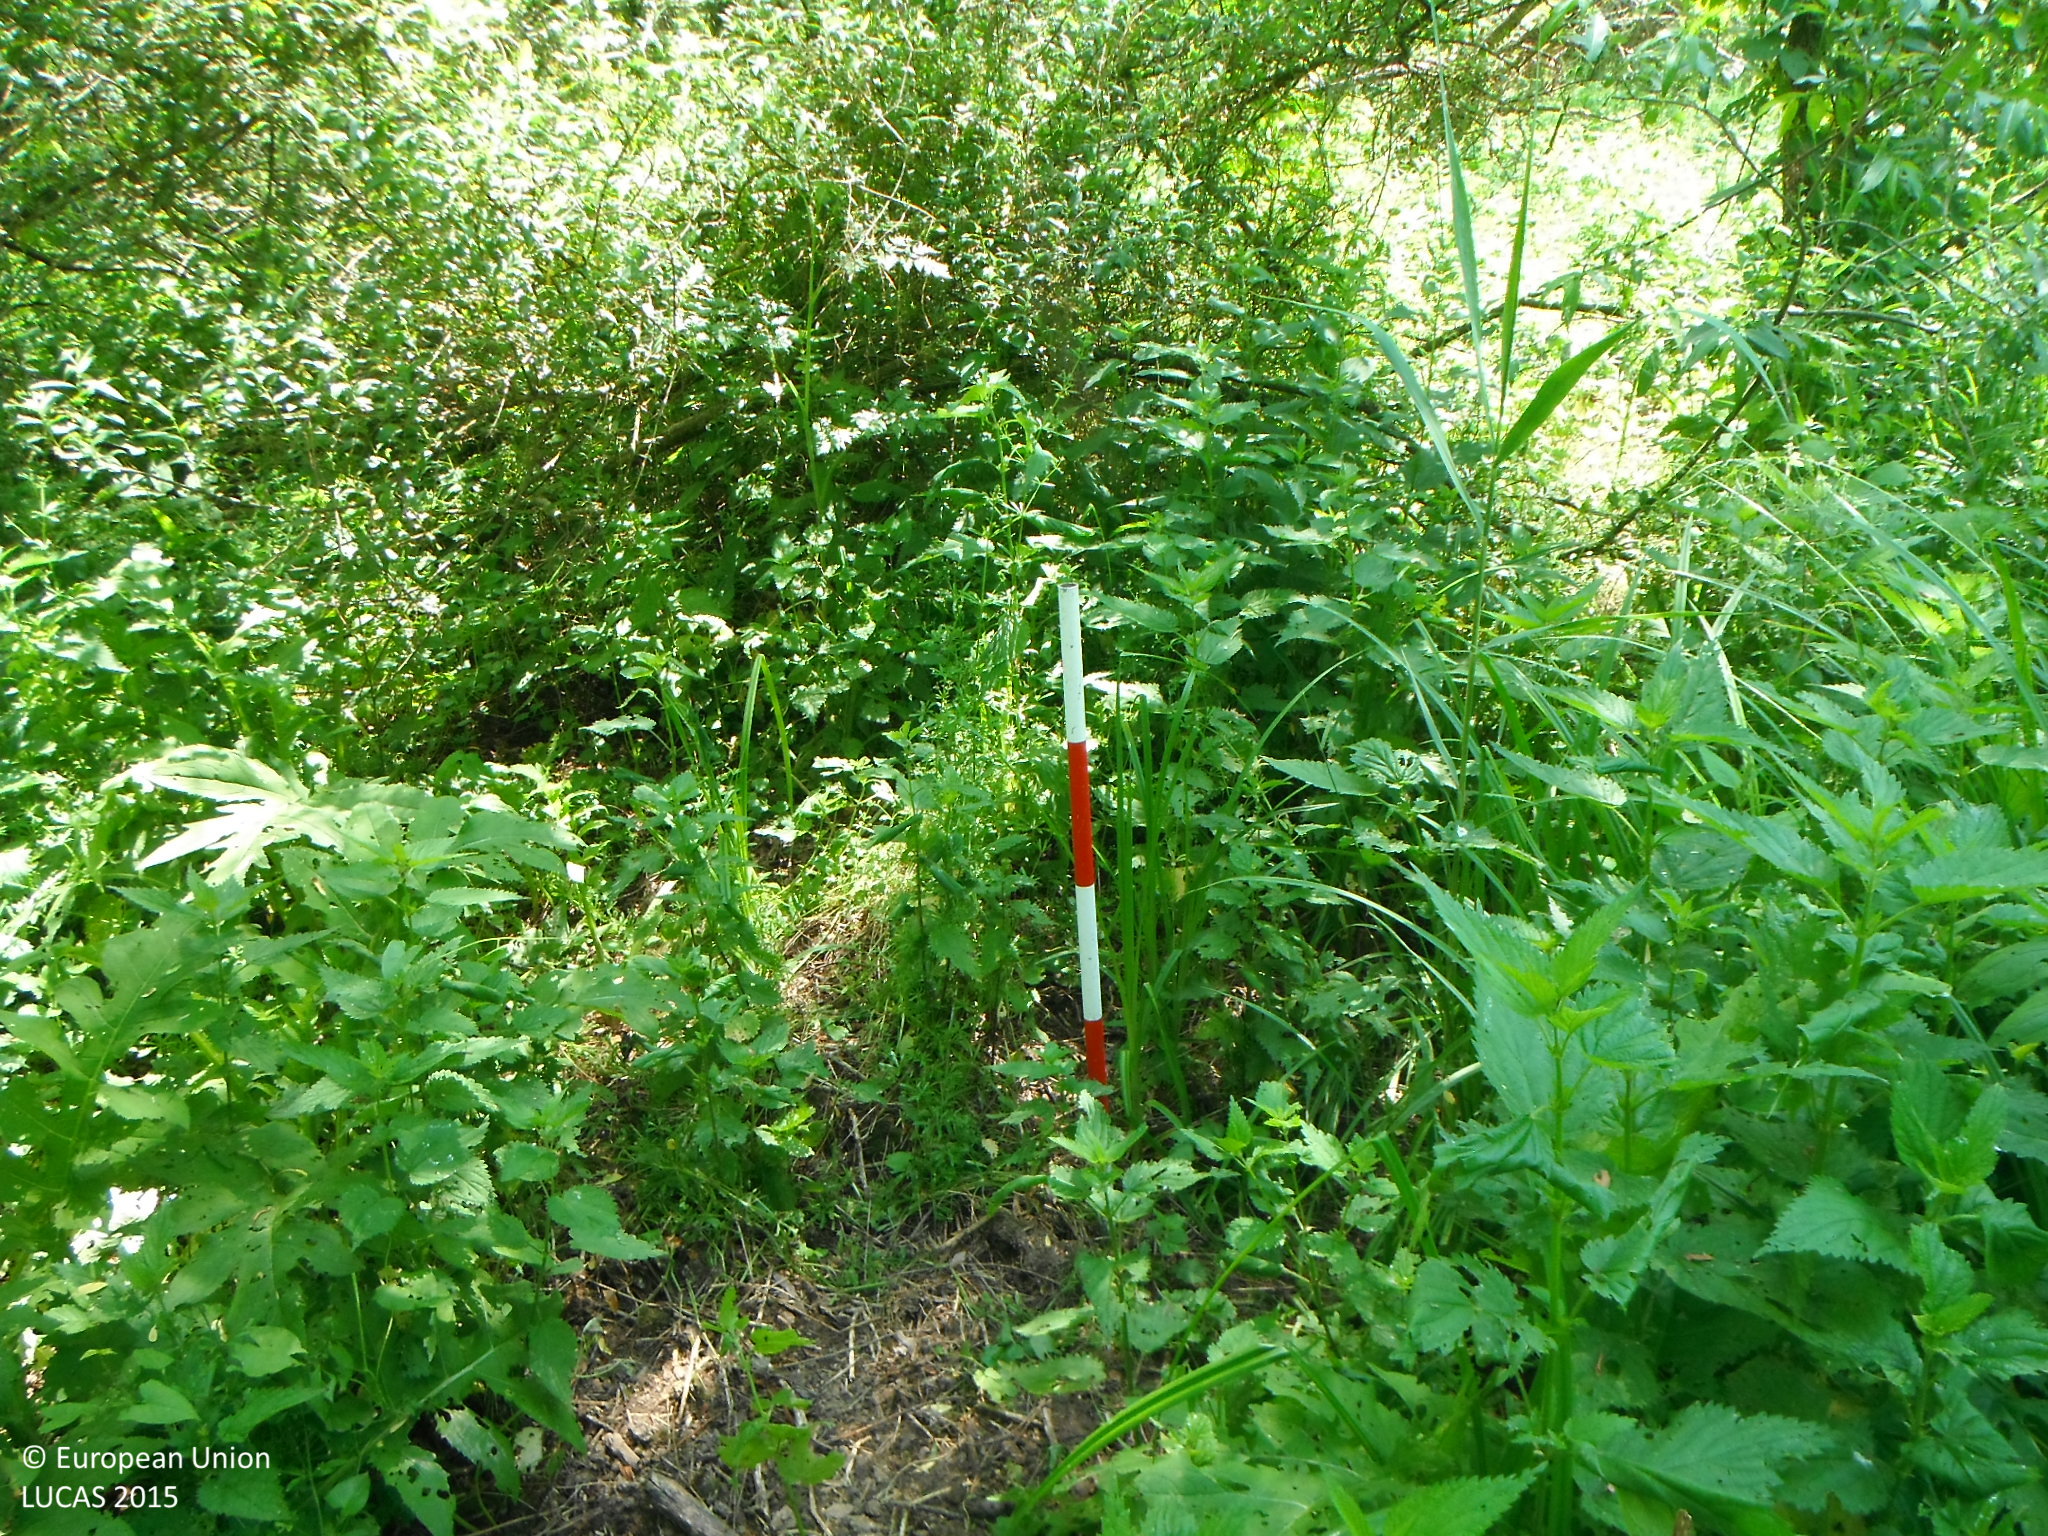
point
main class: Woodland
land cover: Broadleaved woodland
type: mire and swamp forests
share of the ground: > 75 %
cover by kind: broadleaved forest trees 85 %, shrubs 10 %, herbaceous plants 5 %
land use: Semi-natural and natural areas not in use
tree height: > 5 m
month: June
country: SK
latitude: 48.6876
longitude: 19.2191
